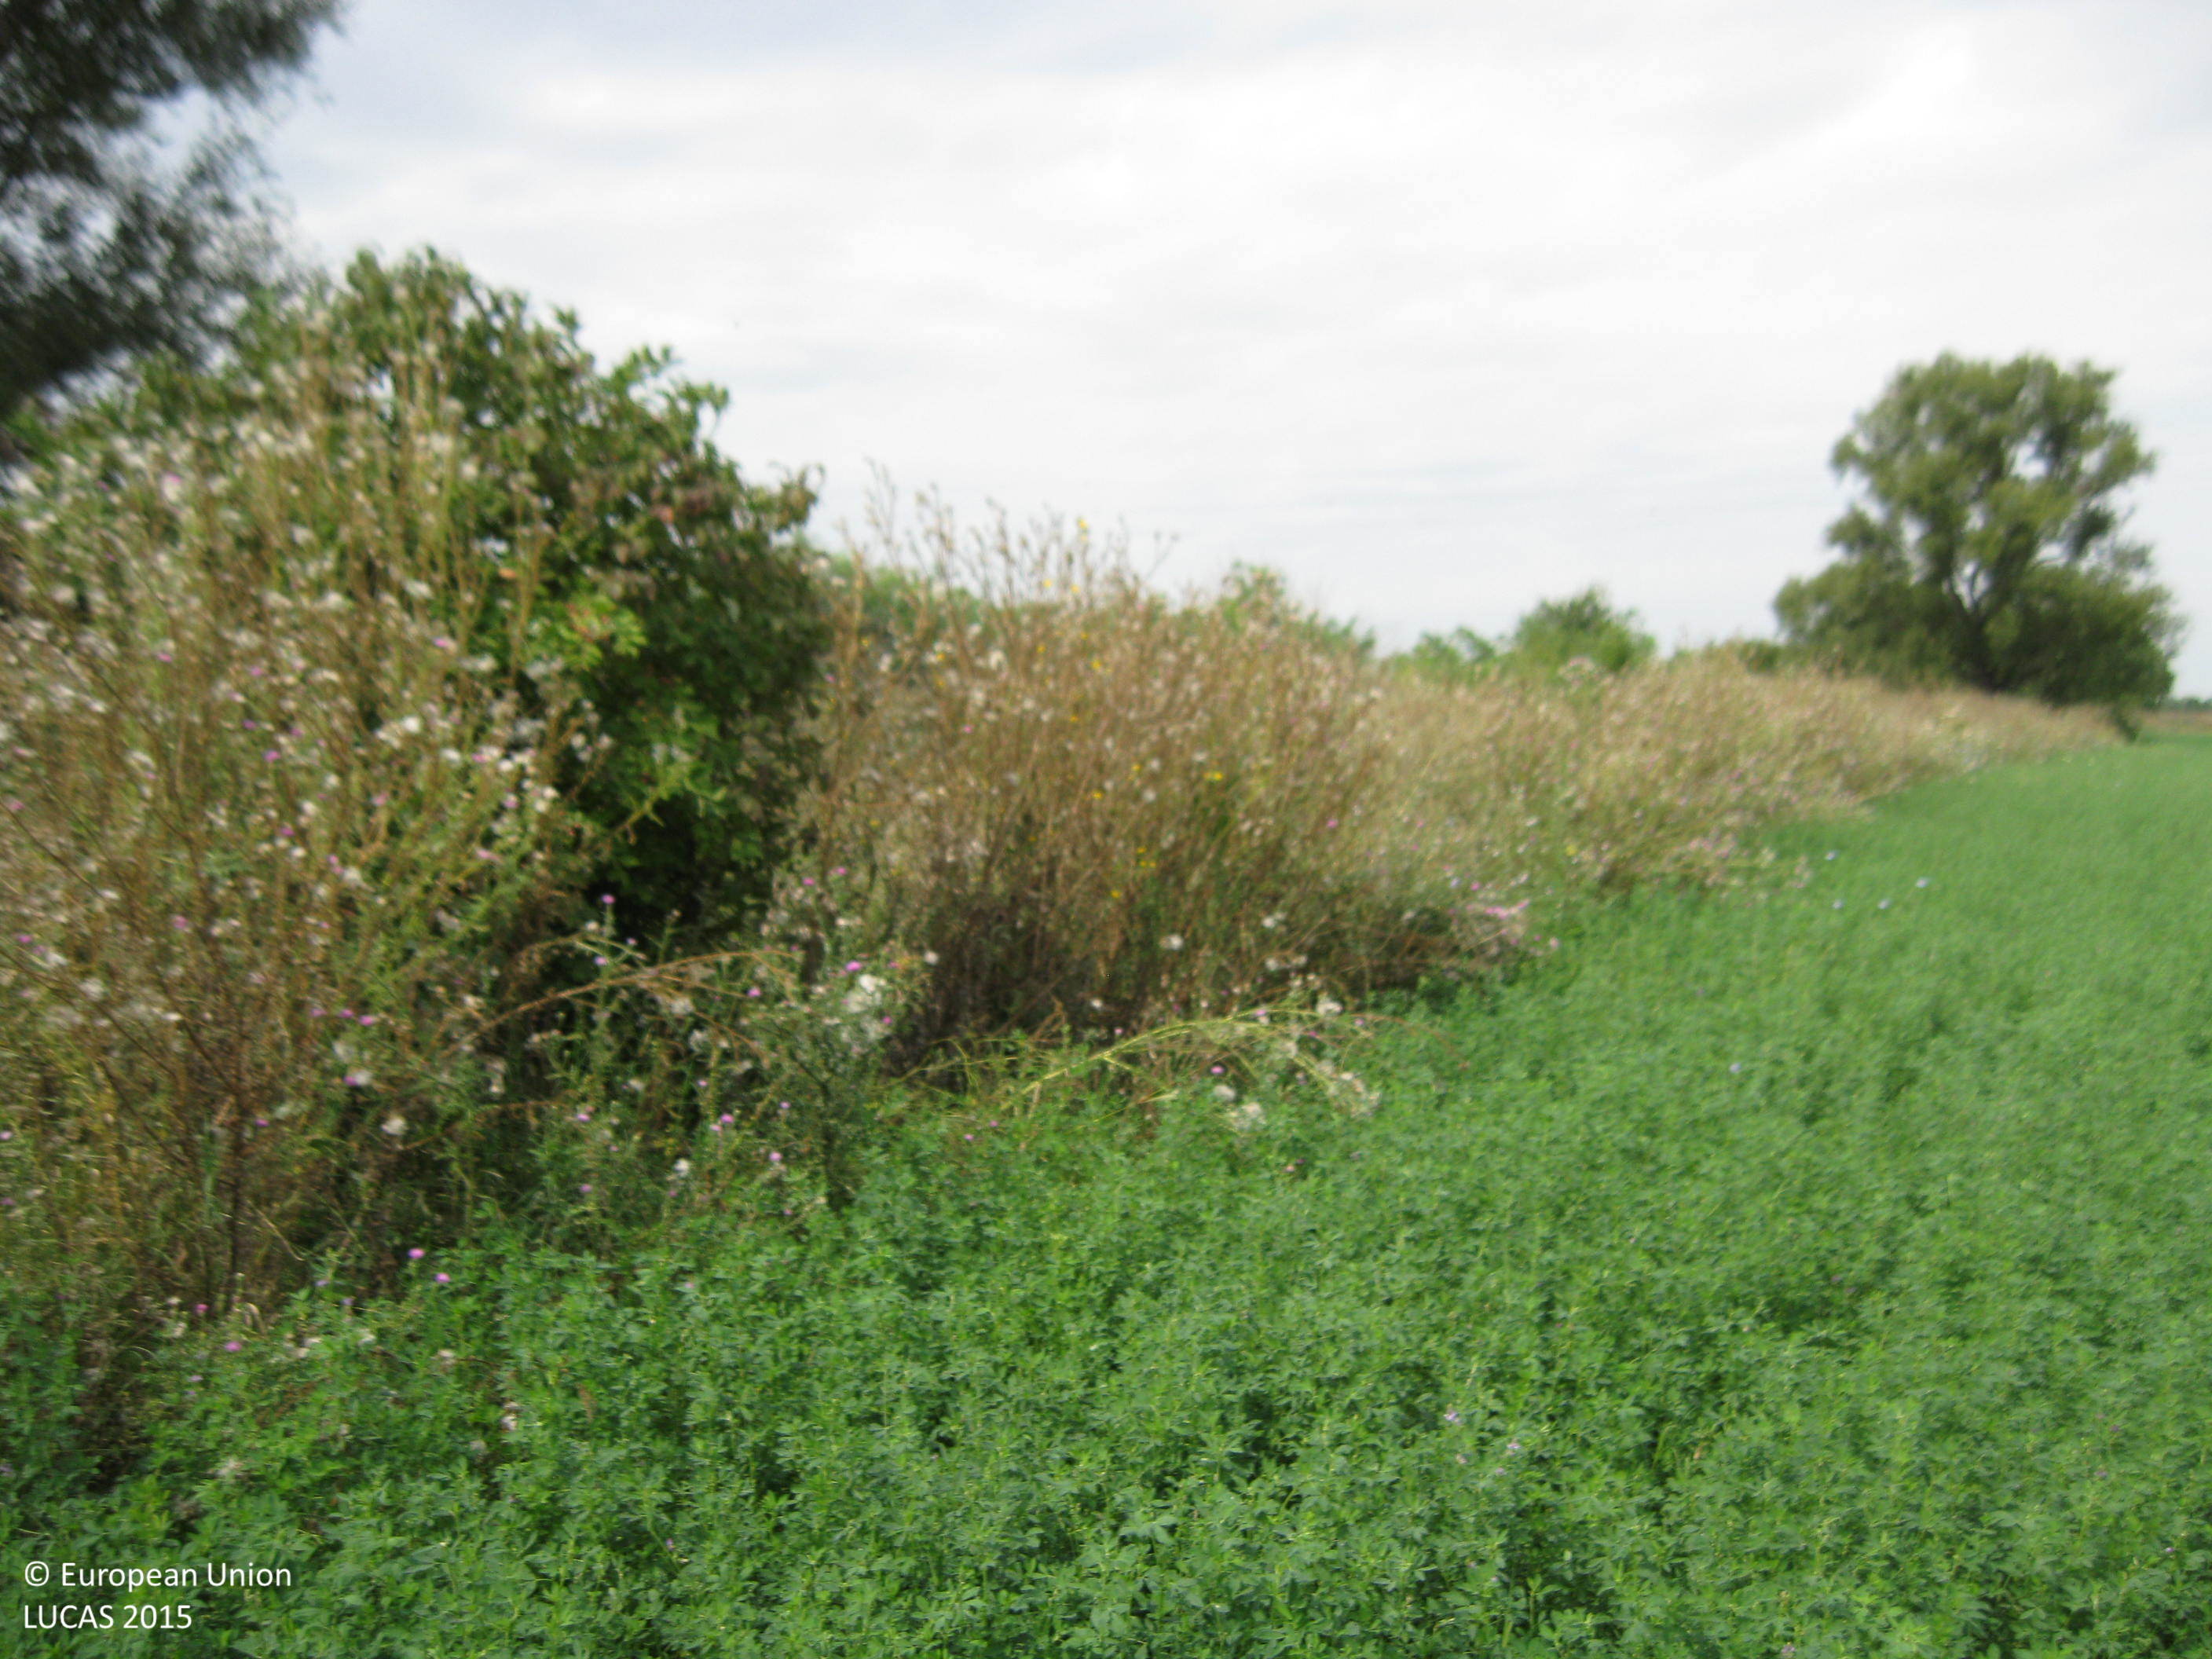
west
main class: Cropland
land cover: Lucerne
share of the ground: > 75 %
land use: Agriculture (excluding fallow land and kitchen gardens)
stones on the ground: < 10 %
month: September
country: BG
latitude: 42.1526
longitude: 25.1252
